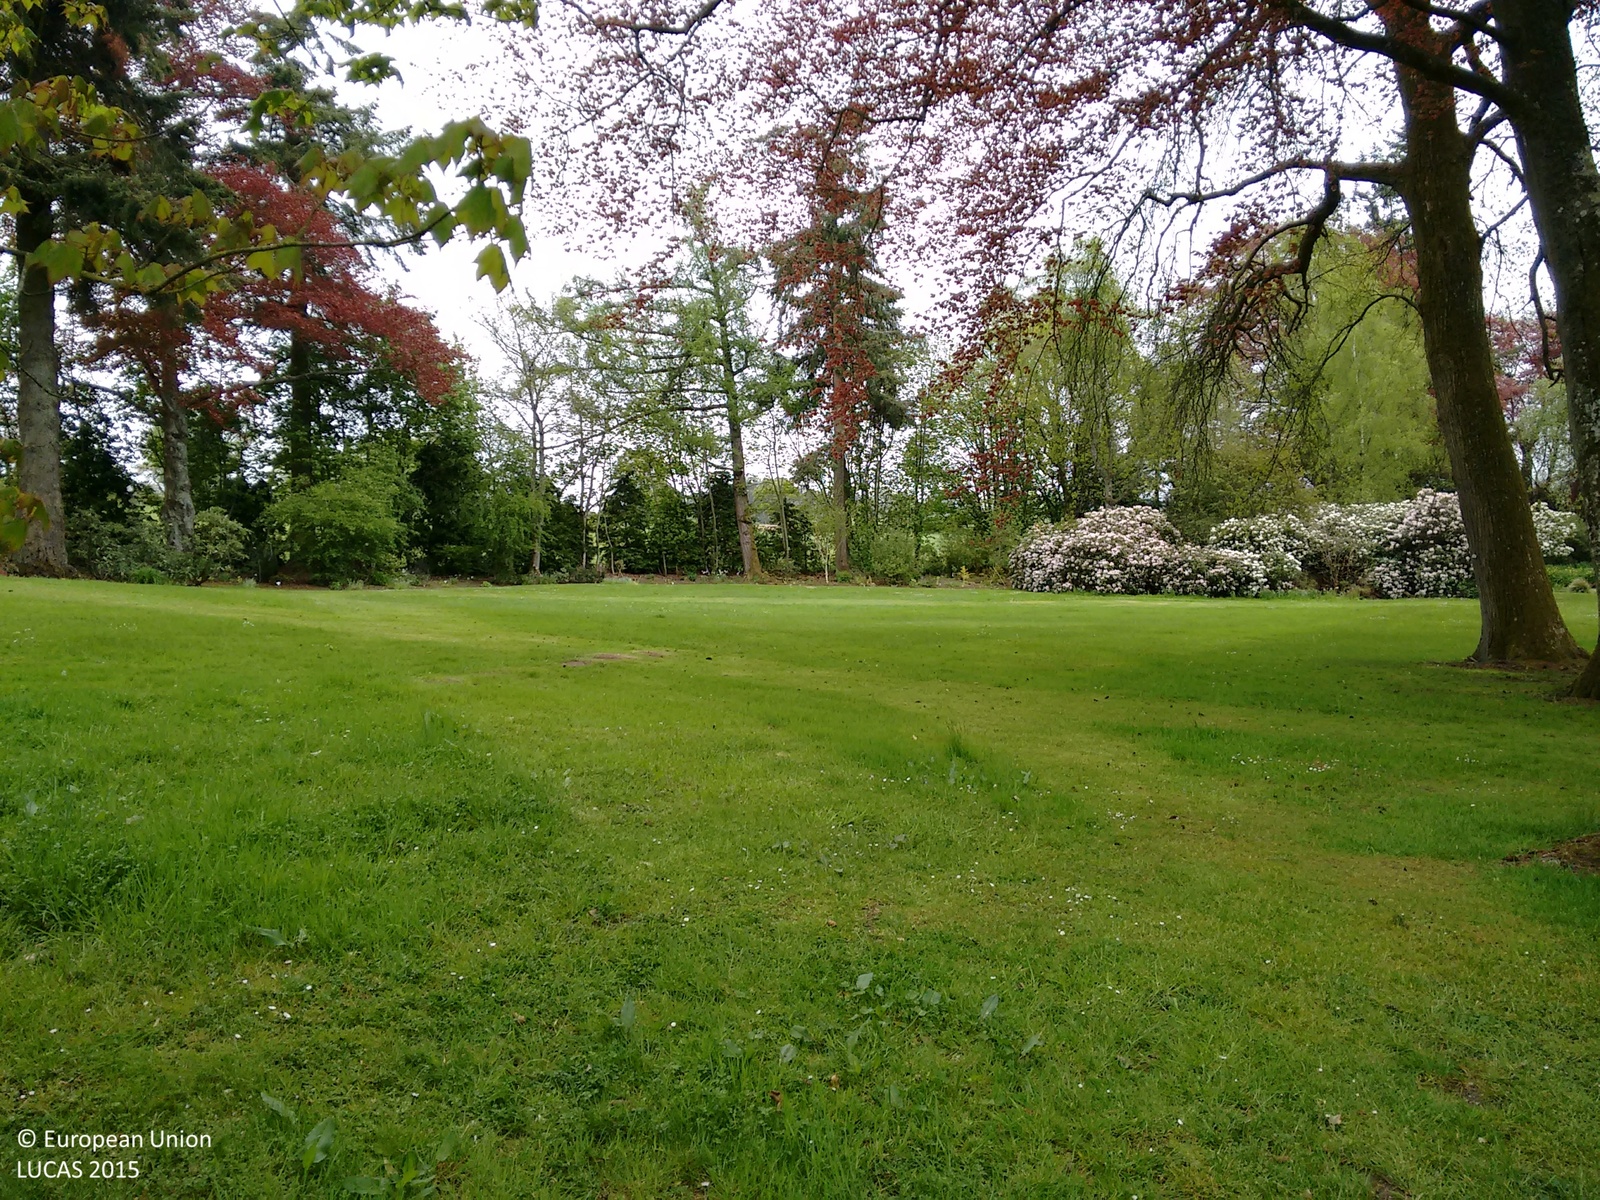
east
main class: Woodland
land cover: Other mixed woodland
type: exotic forest
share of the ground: > 75 %
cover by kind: broadleaved forest trees 45 %, coniferous forest trees 20 %, shrubs 20 %, herbaceous plants 15 %
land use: Residential
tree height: > 5 m
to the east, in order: Other mixed woodland; Grassland without tree/shrub cover; Other mixed woodland; Fences; Grassland without tree/shrub cover; Fences; Grassland without tree/shrub cover; Electric lines; Tracks; Grassland without tree/shrub cover; Fences; Grass margins; Rye
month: May
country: GB
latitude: 56.3171
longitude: -3.7752
